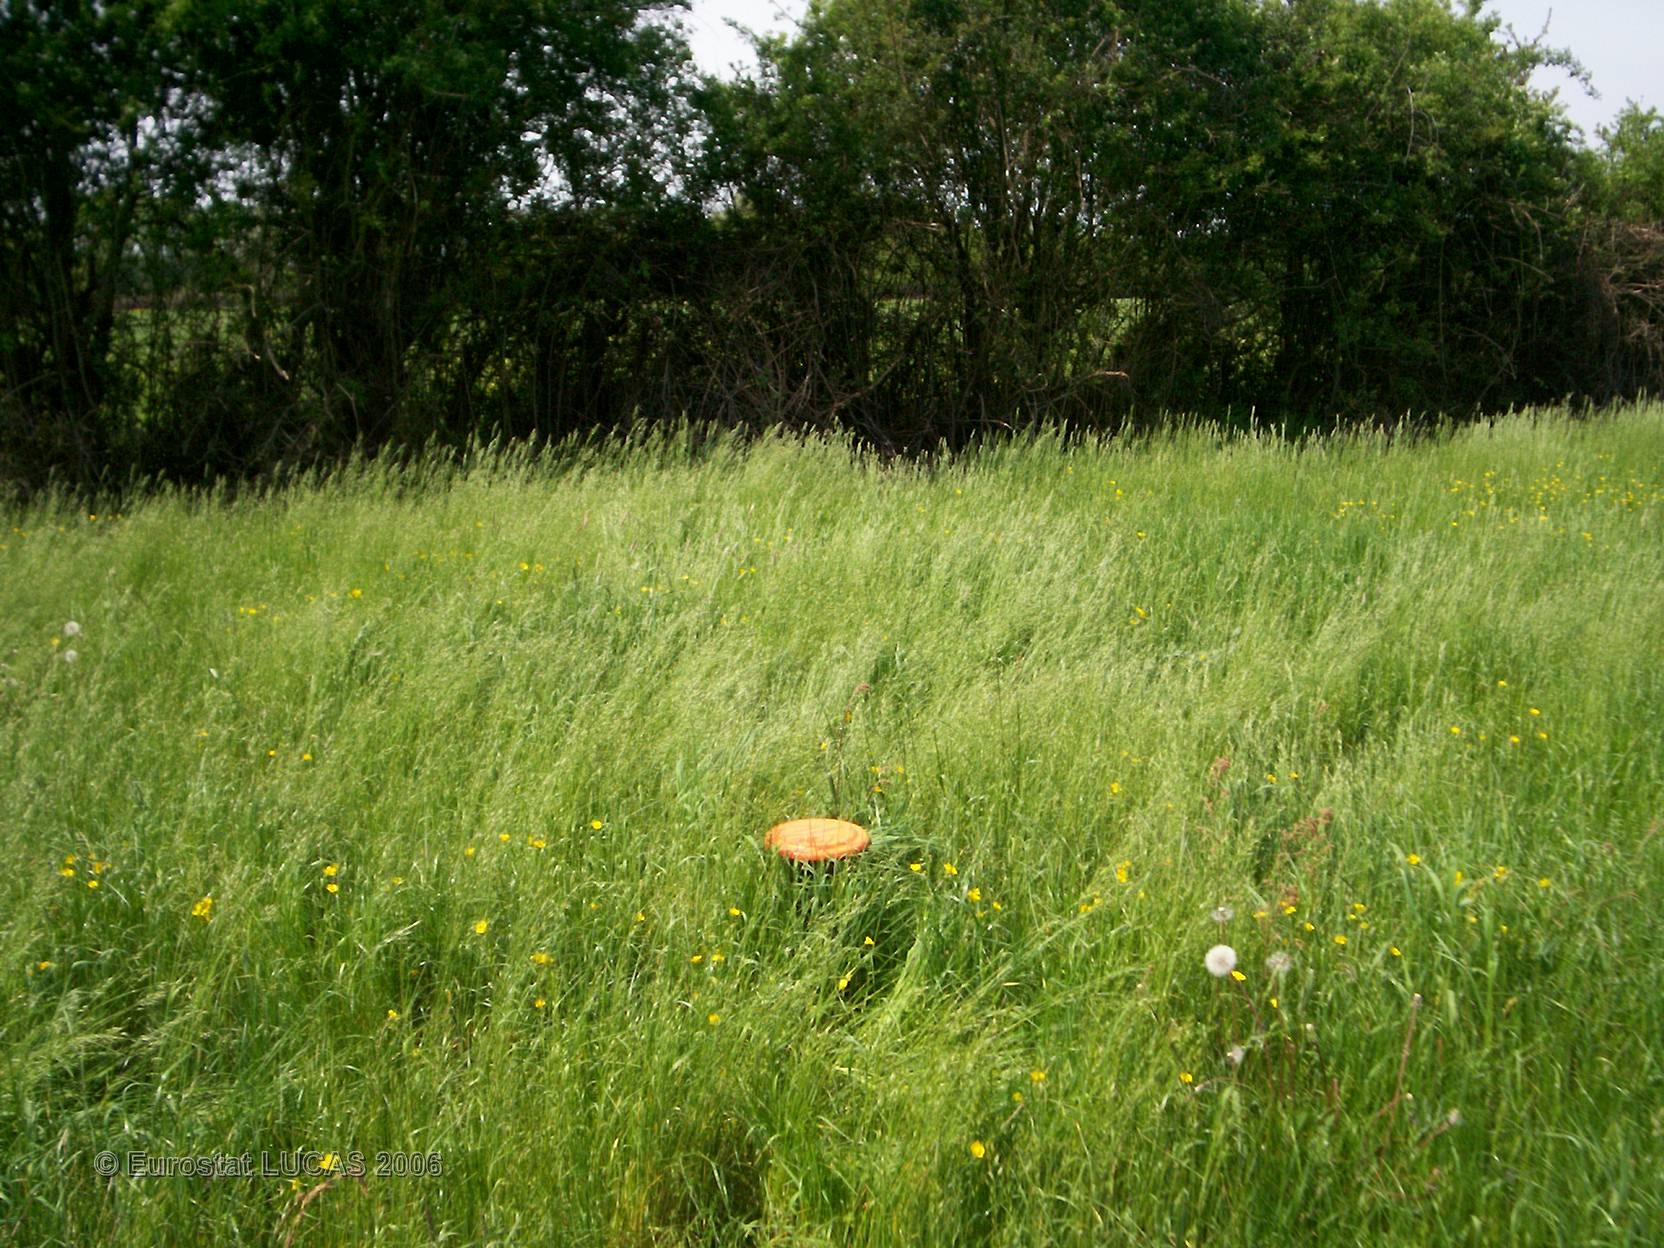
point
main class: Grassland
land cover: Grassland without tree/shrub cover
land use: Agriculture (excluding fallow land and kitchen gardens)
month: May
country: FR
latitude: 47.3272
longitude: 0.5452
